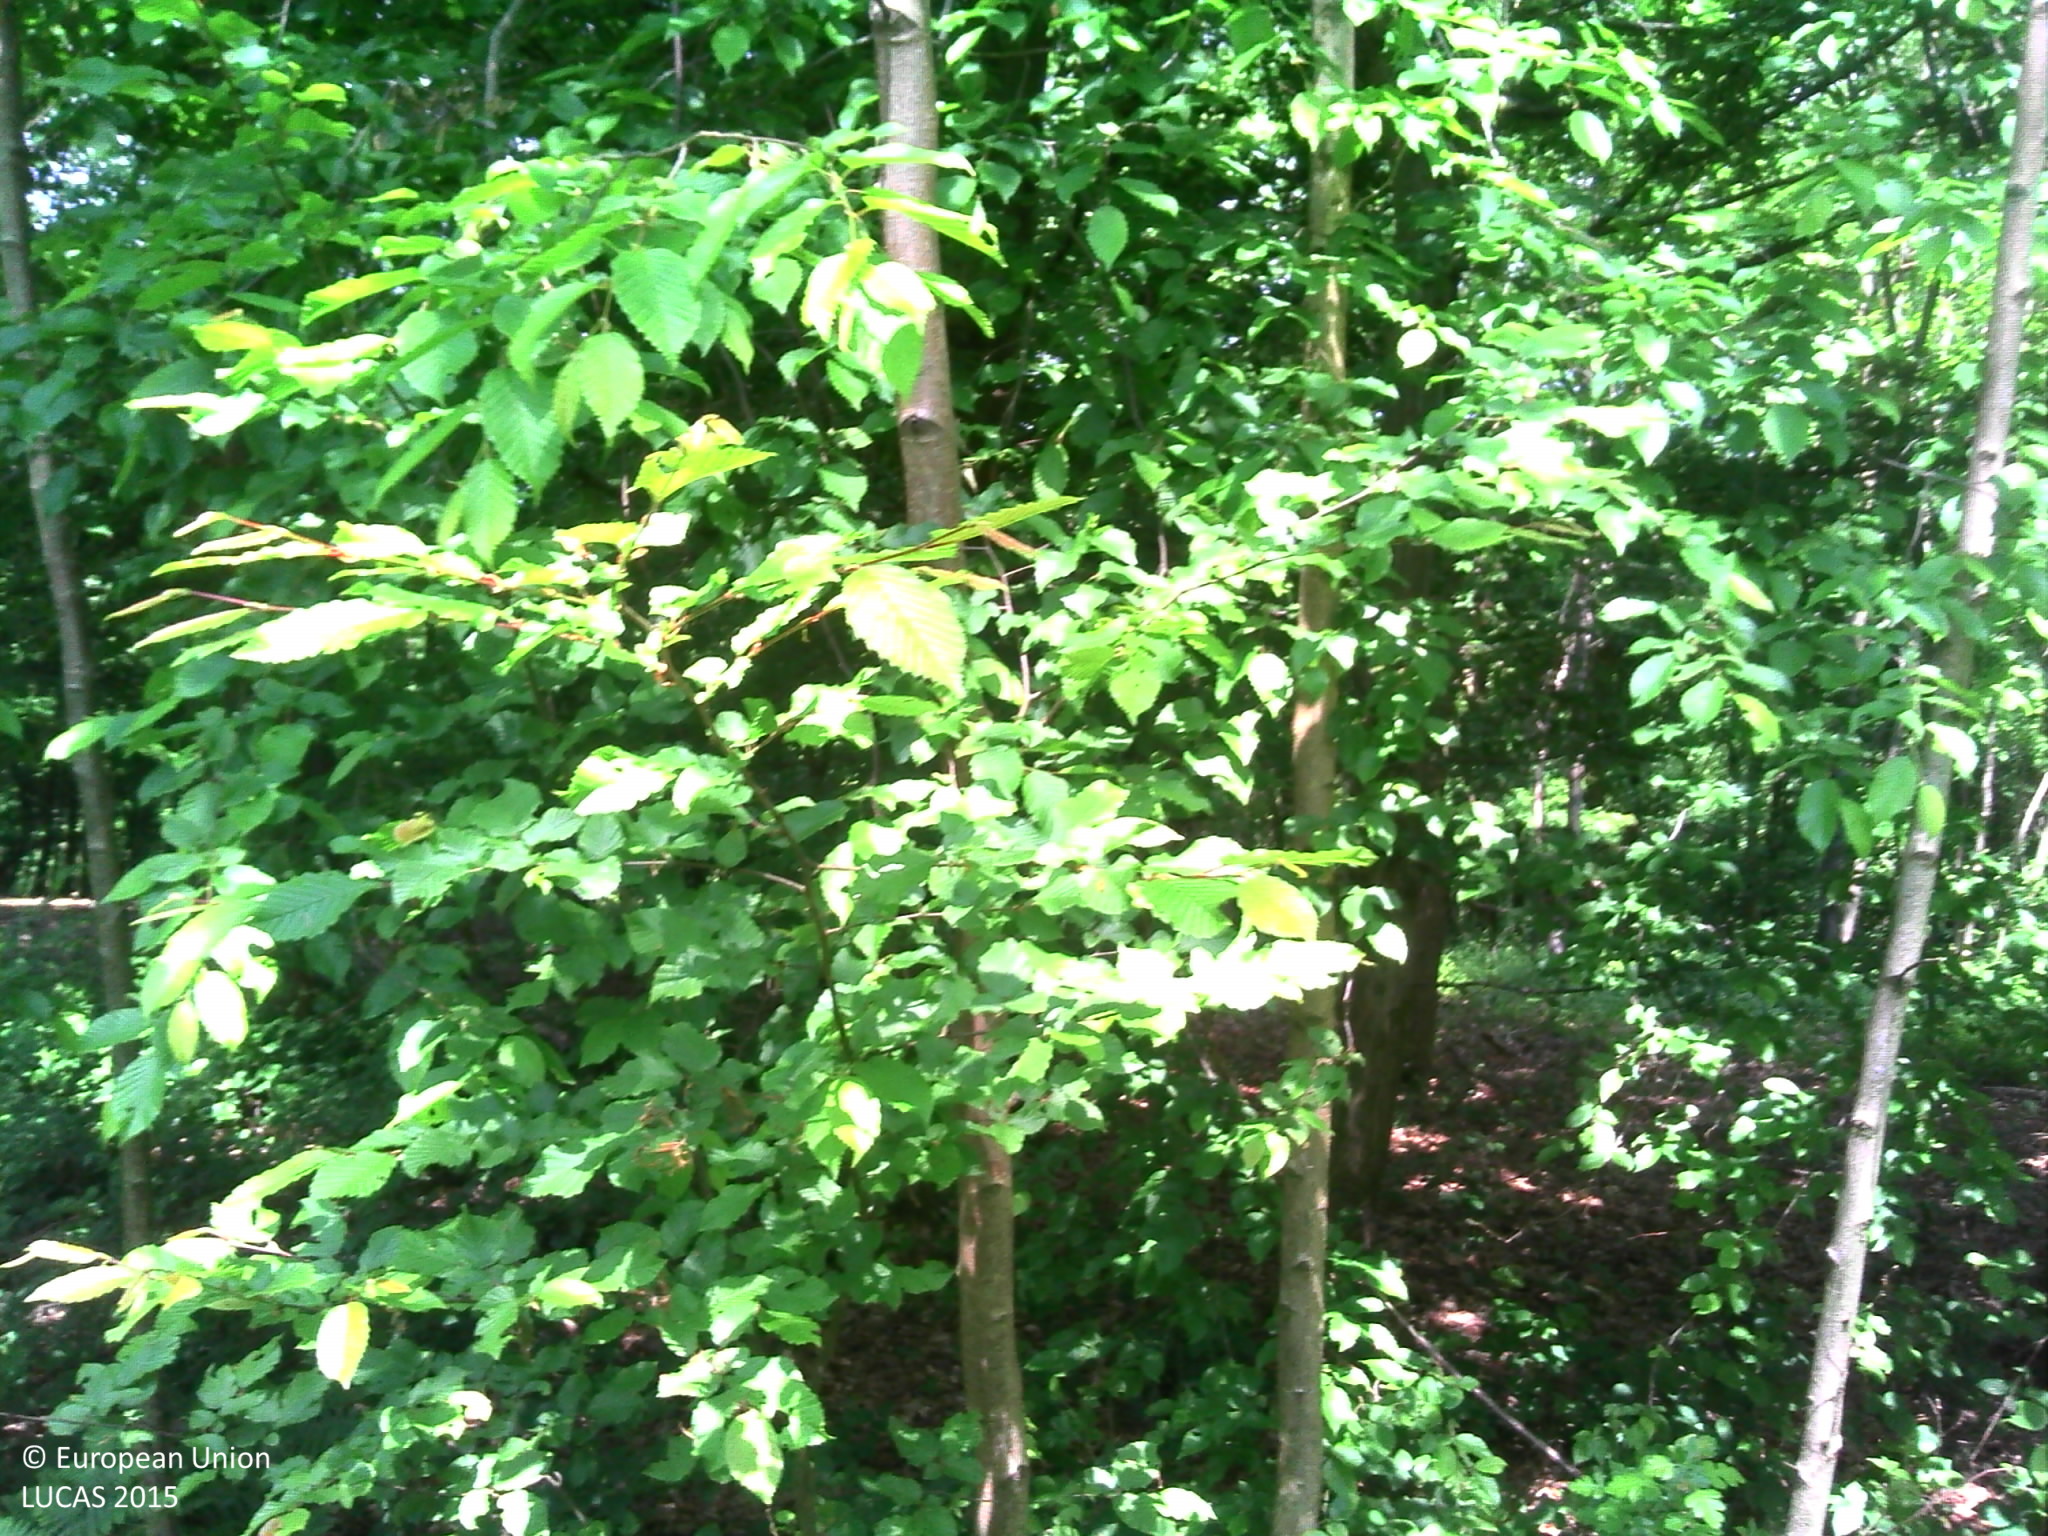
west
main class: Woodland
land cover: Broadleaved woodland
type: acidophilous oak and oak-birch forest
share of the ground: > 75 %
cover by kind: broadleaved forest trees 100 %
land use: Forestry
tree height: > 5 m
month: May
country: BE
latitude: 50.6102
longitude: 4.4987
